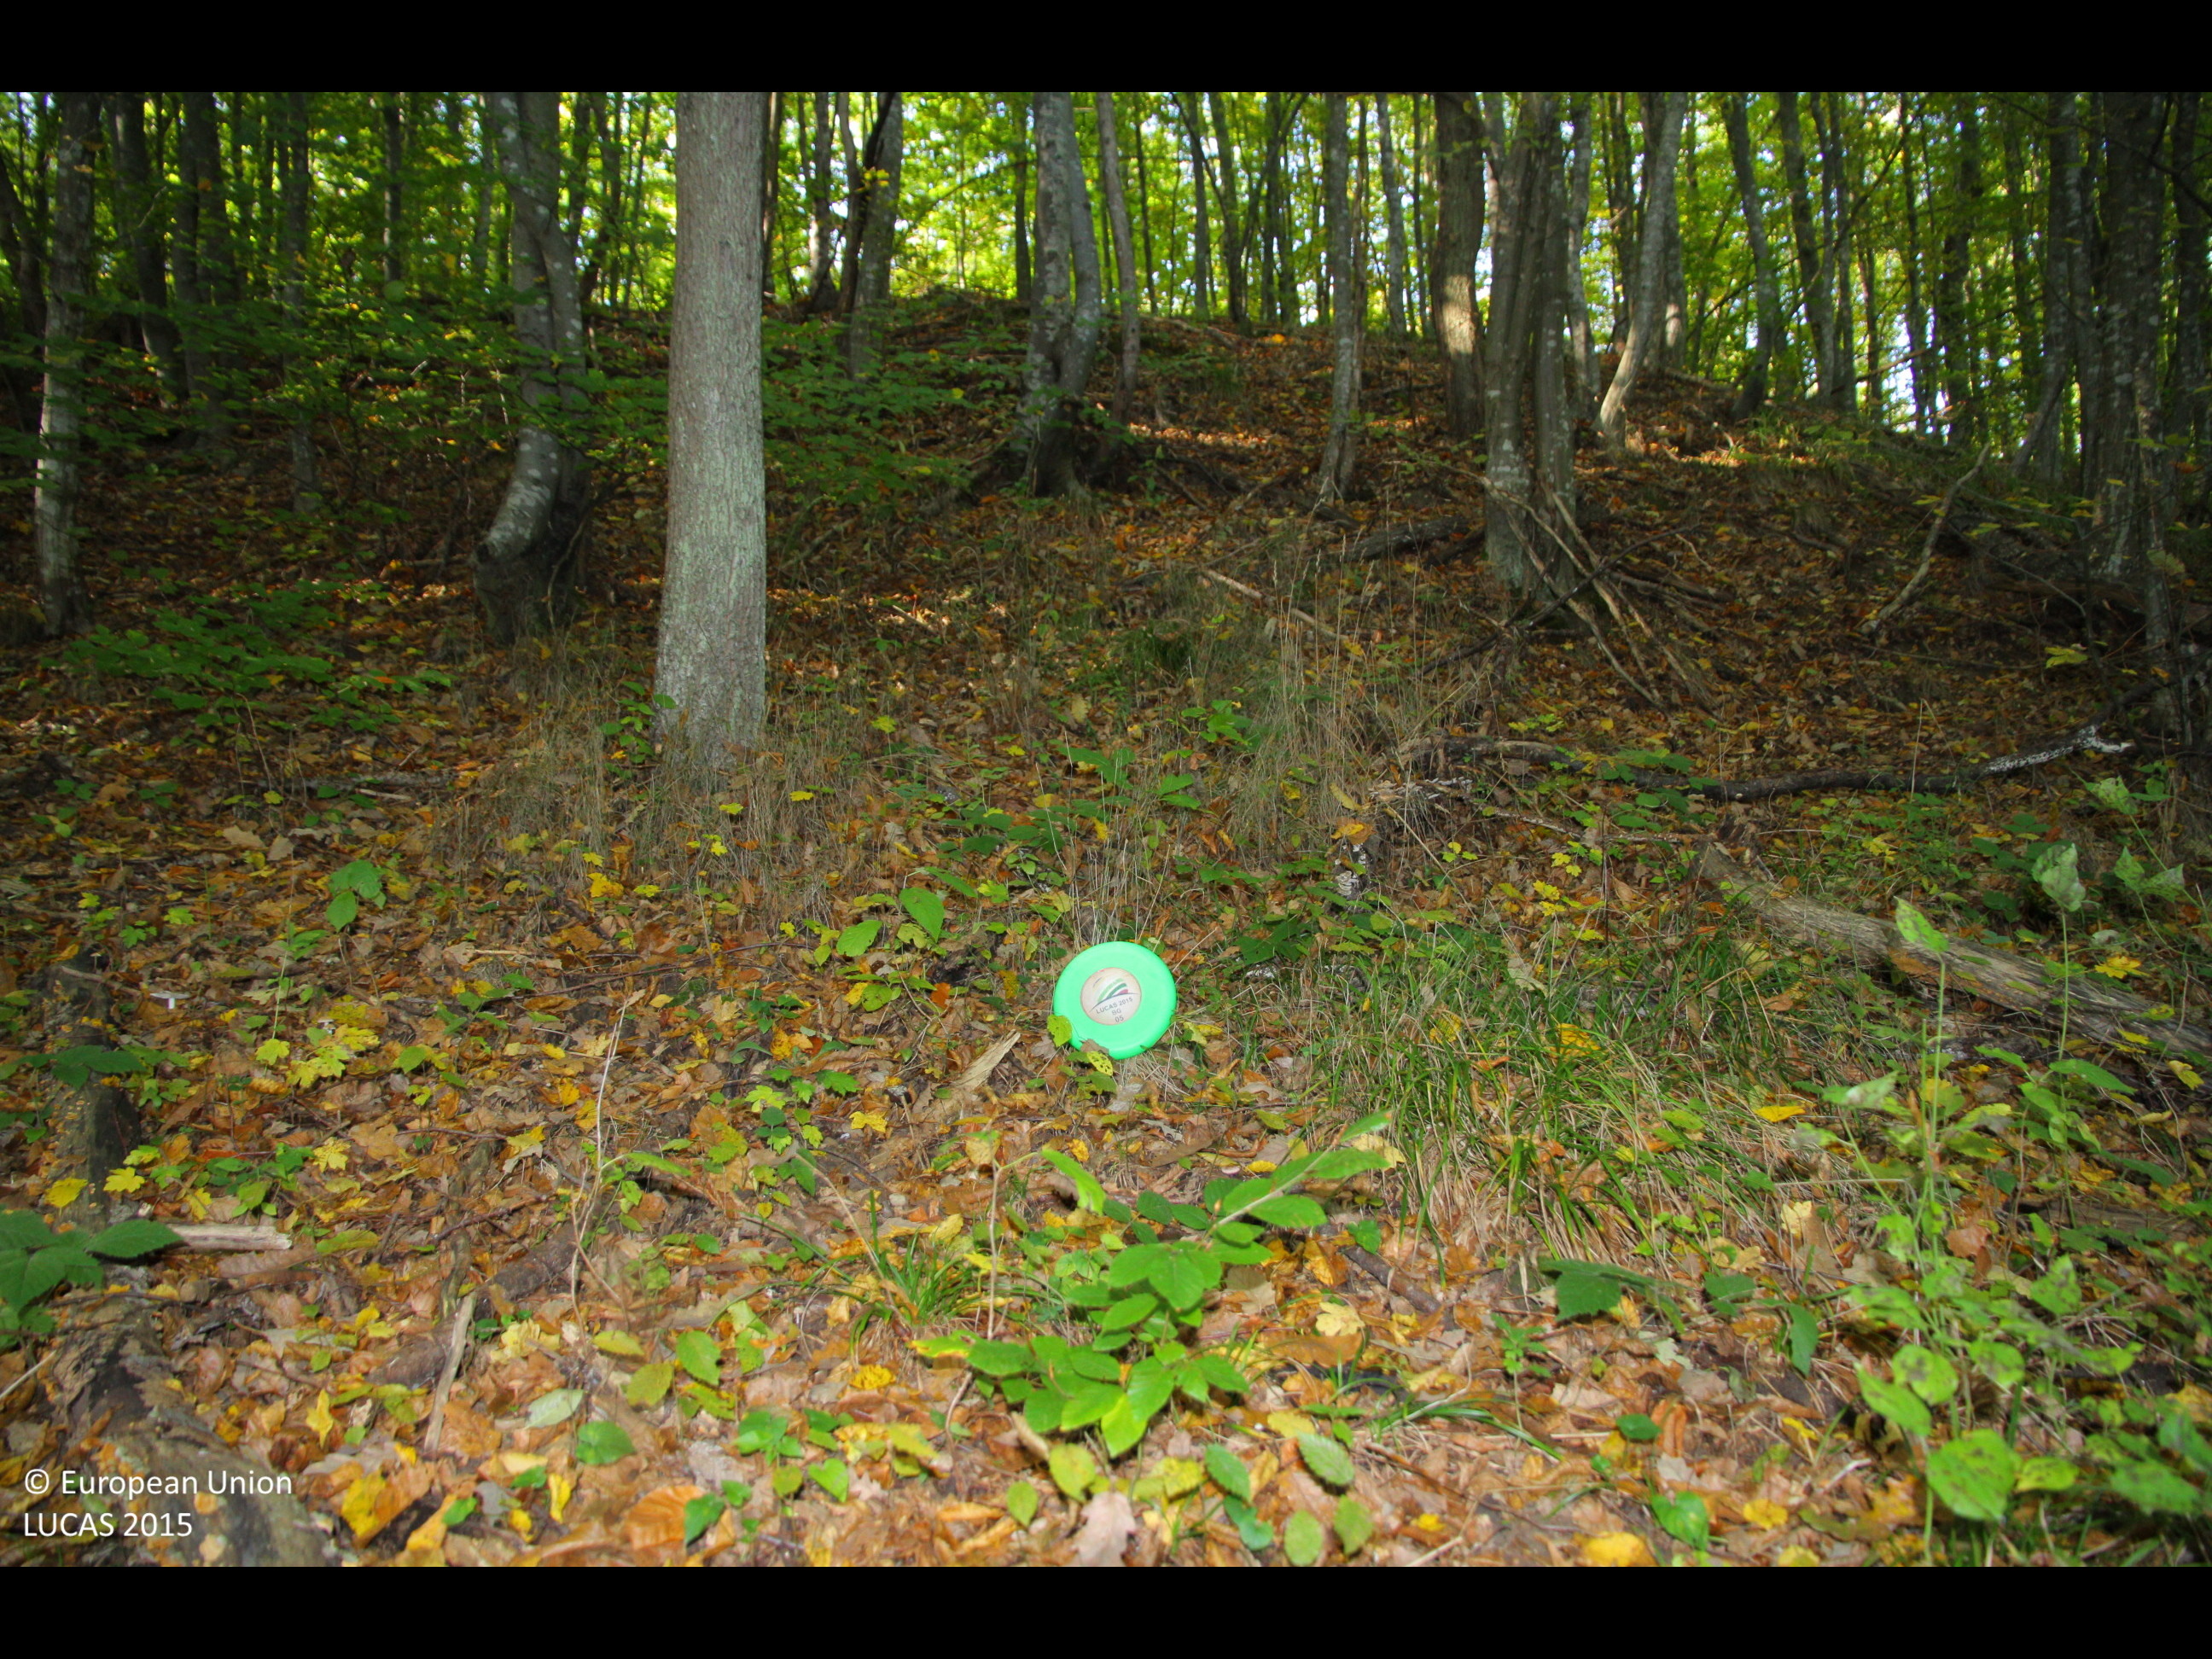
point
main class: Woodland
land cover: Broadleaved woodland
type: beech forest
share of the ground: > 75 %
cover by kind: broadleaved forest trees 100 %
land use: Forestry
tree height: > 5 m
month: October
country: BG
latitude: 42.9756
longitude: 26.8695
